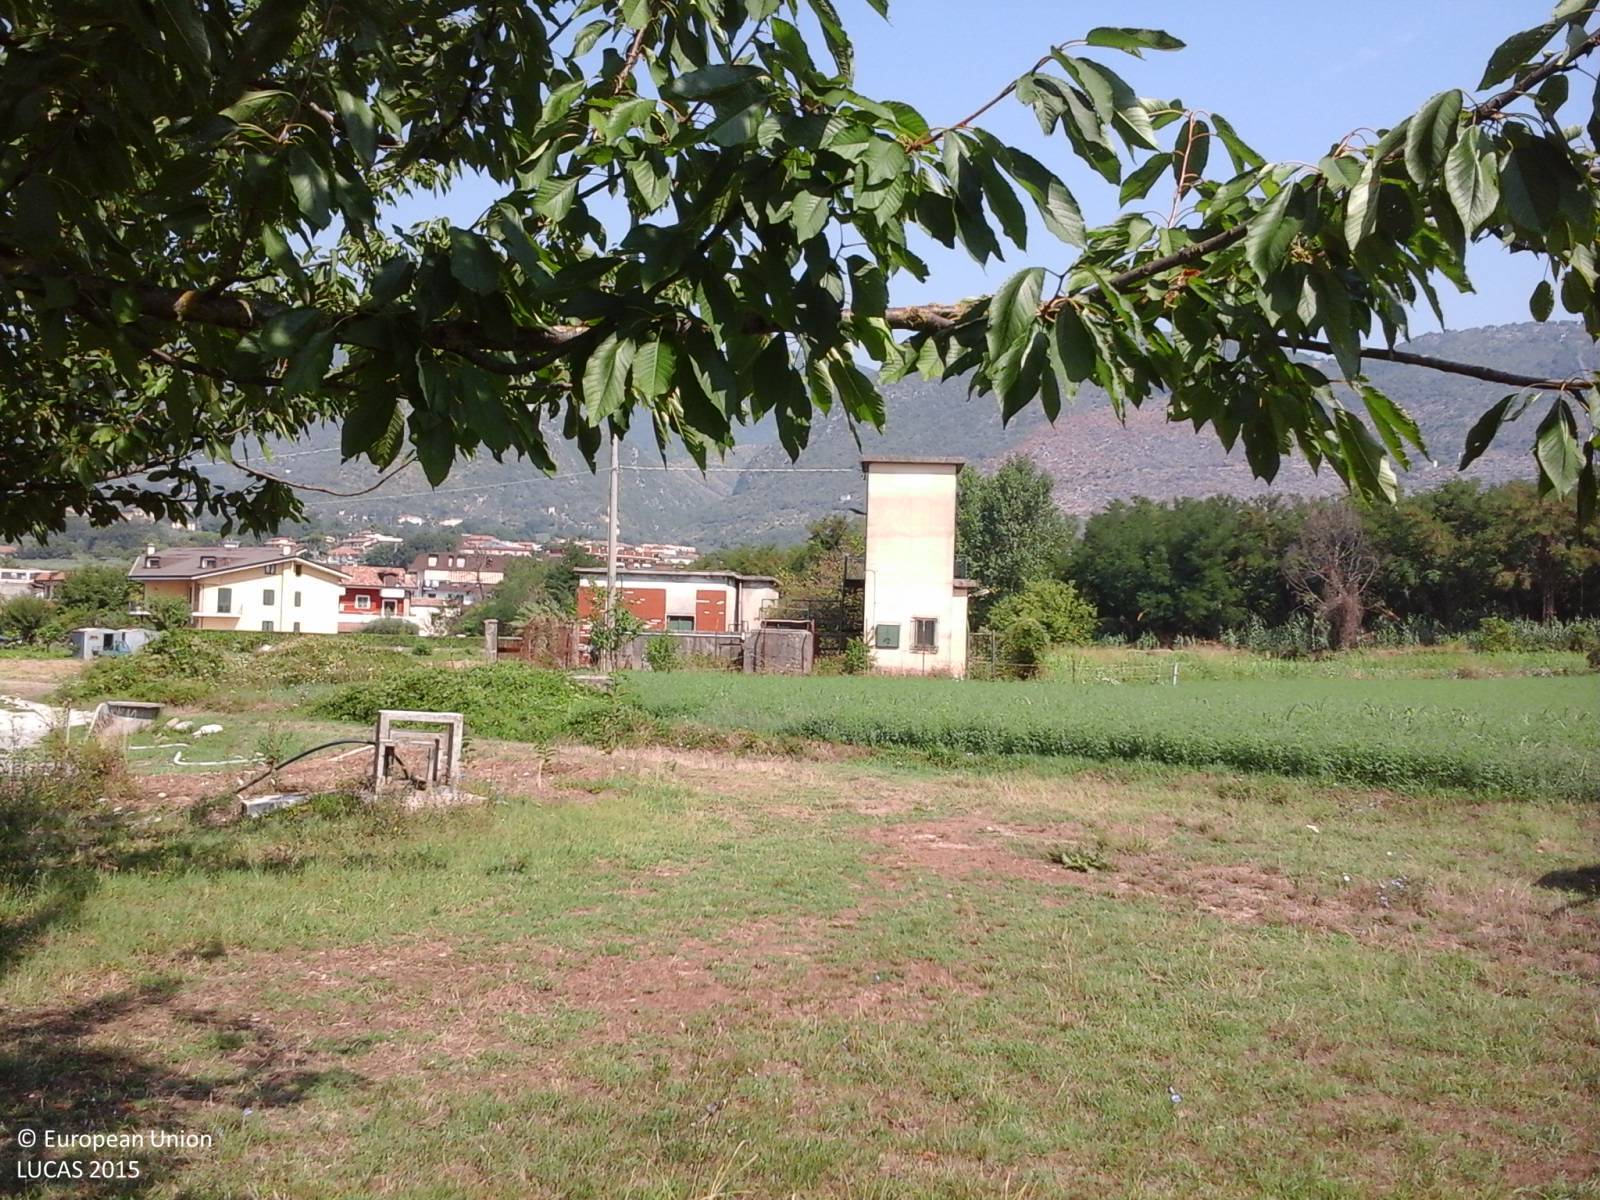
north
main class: Grassland
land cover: Grassland with sparse tree/shrub cover
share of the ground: > 75 %
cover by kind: herbaceous plants 95 %, broadleaved forest trees 5 %
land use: Amenities, museums, leisure
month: August
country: IT
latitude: 41.3474
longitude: 14.3698
